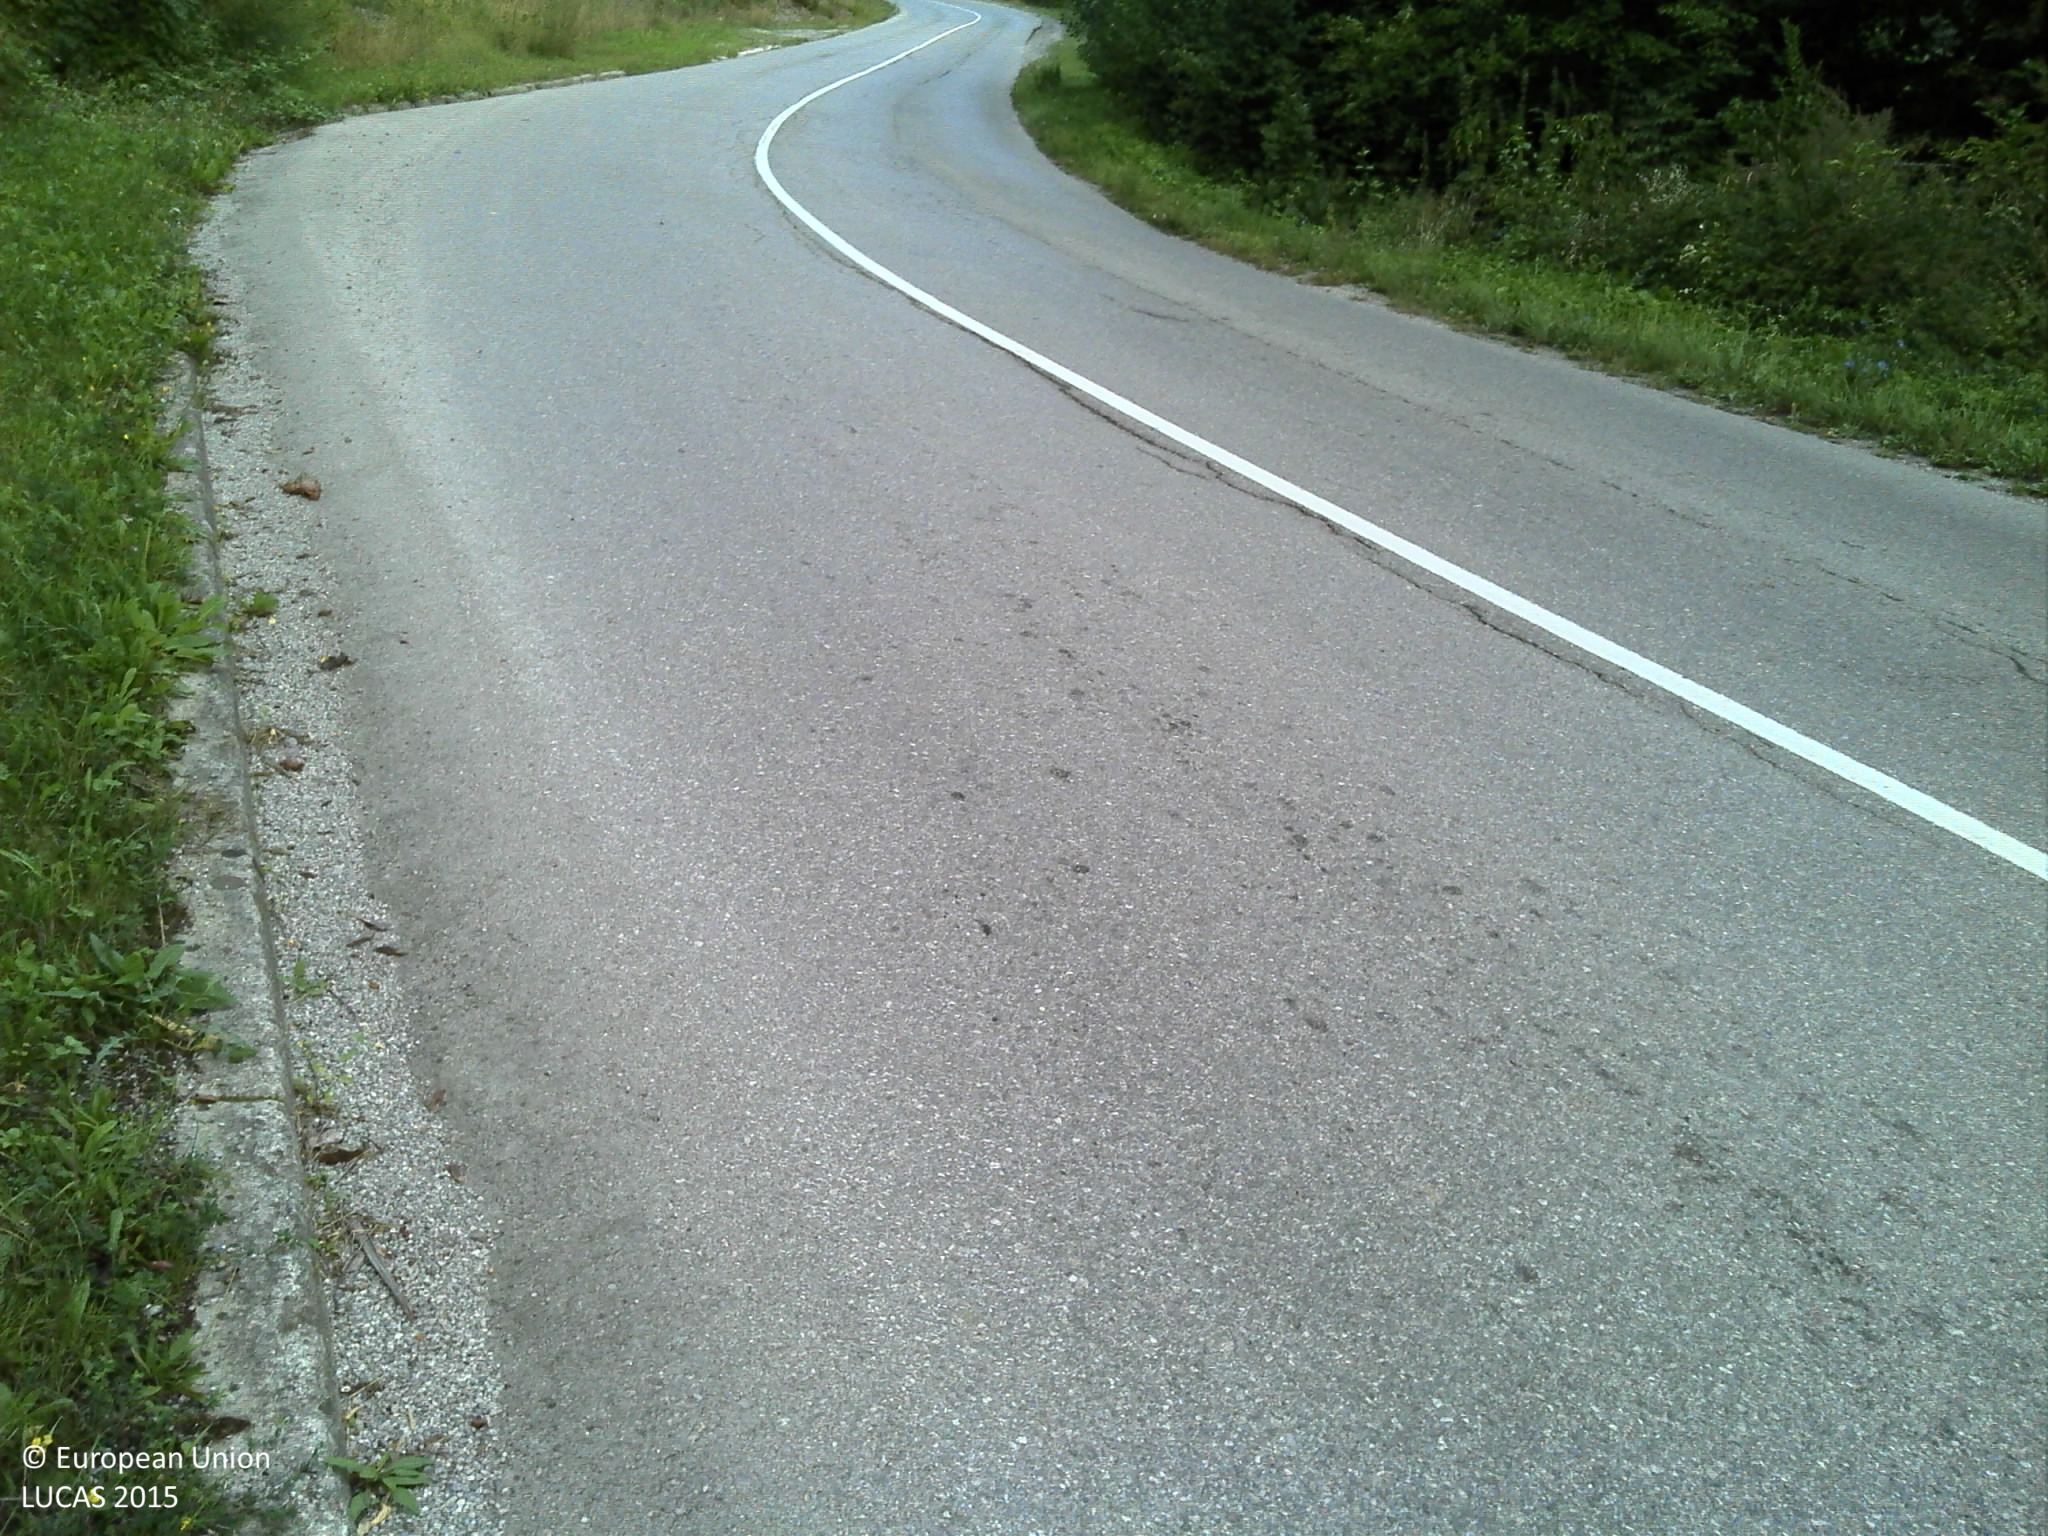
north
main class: Grassland
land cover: Spontaneously vegetated surfaces
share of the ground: > 75 %
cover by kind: herbaceous plants 100 %
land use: Fallow land
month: September
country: HR
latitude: 45.2688
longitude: 15.1827
